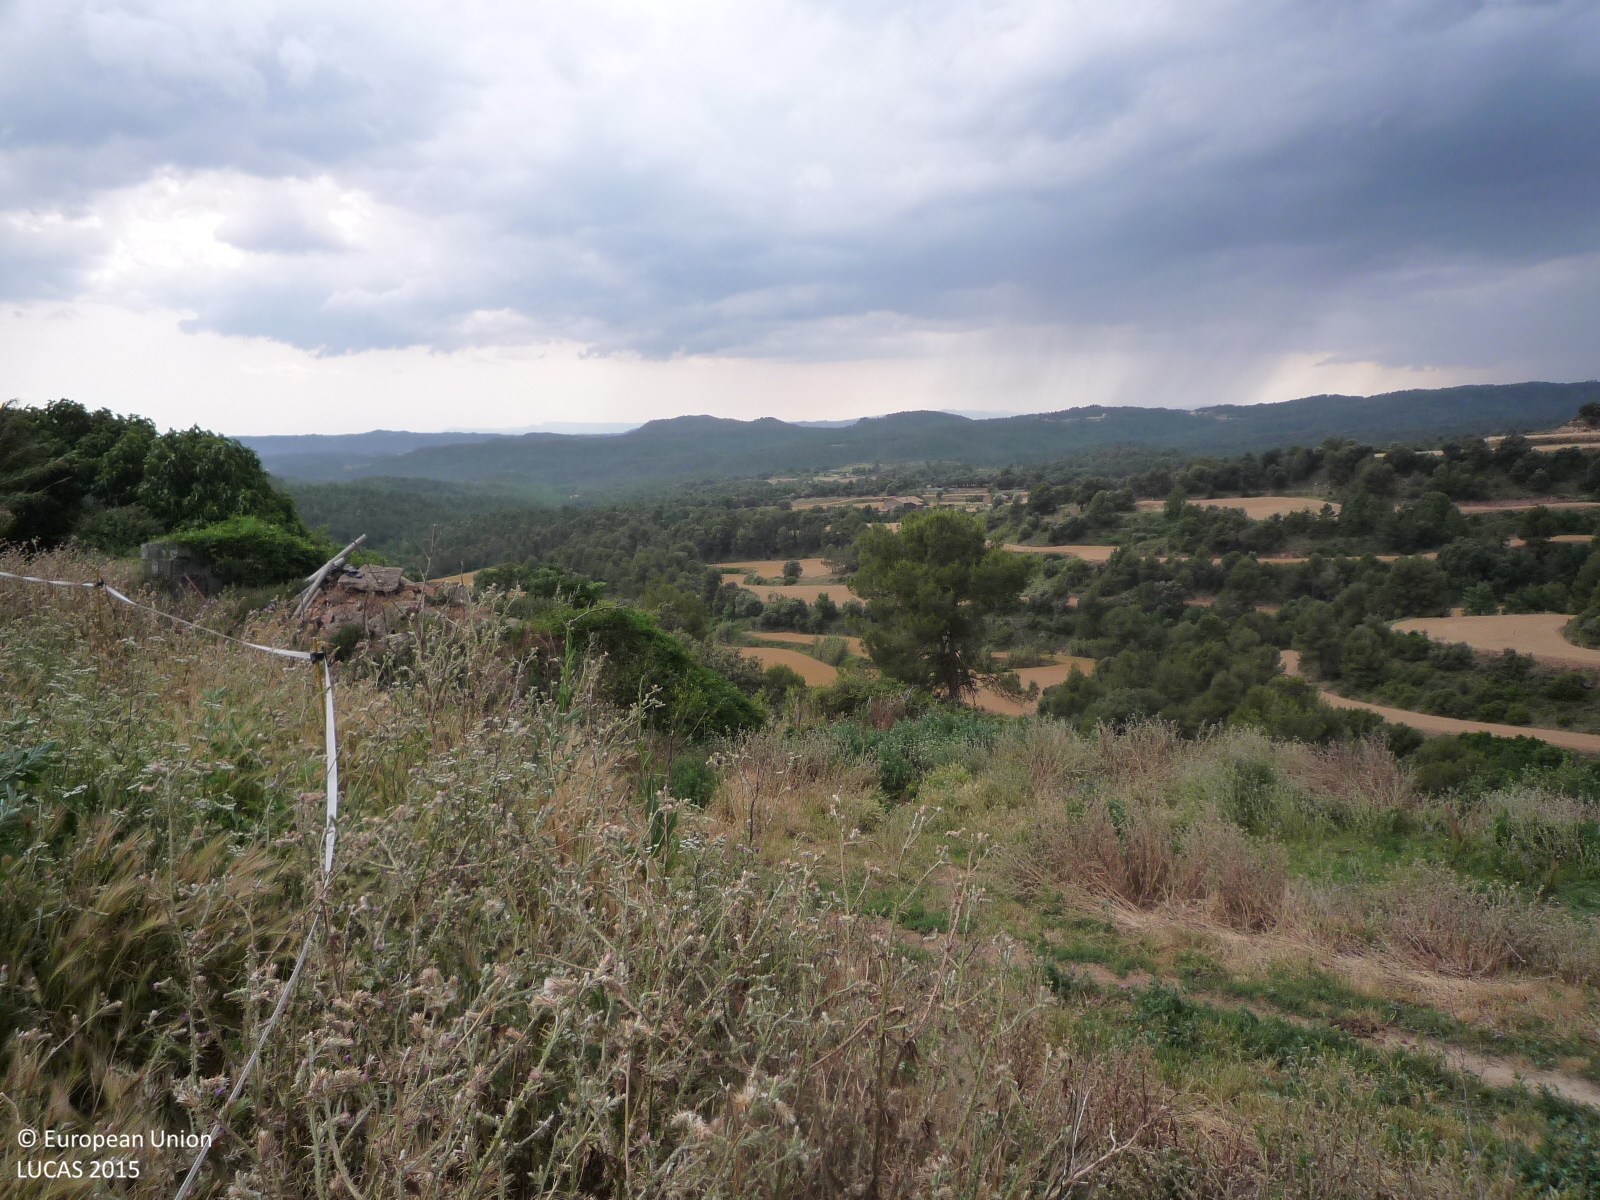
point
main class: Shrubland
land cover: Shrubland with sparse tree cover
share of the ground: > 75 %
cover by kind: shrubs 95 %, broadleaved forest trees 5 %
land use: Semi-natural and natural areas not in use
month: June
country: ES
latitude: 41.9395
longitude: 2.0176
